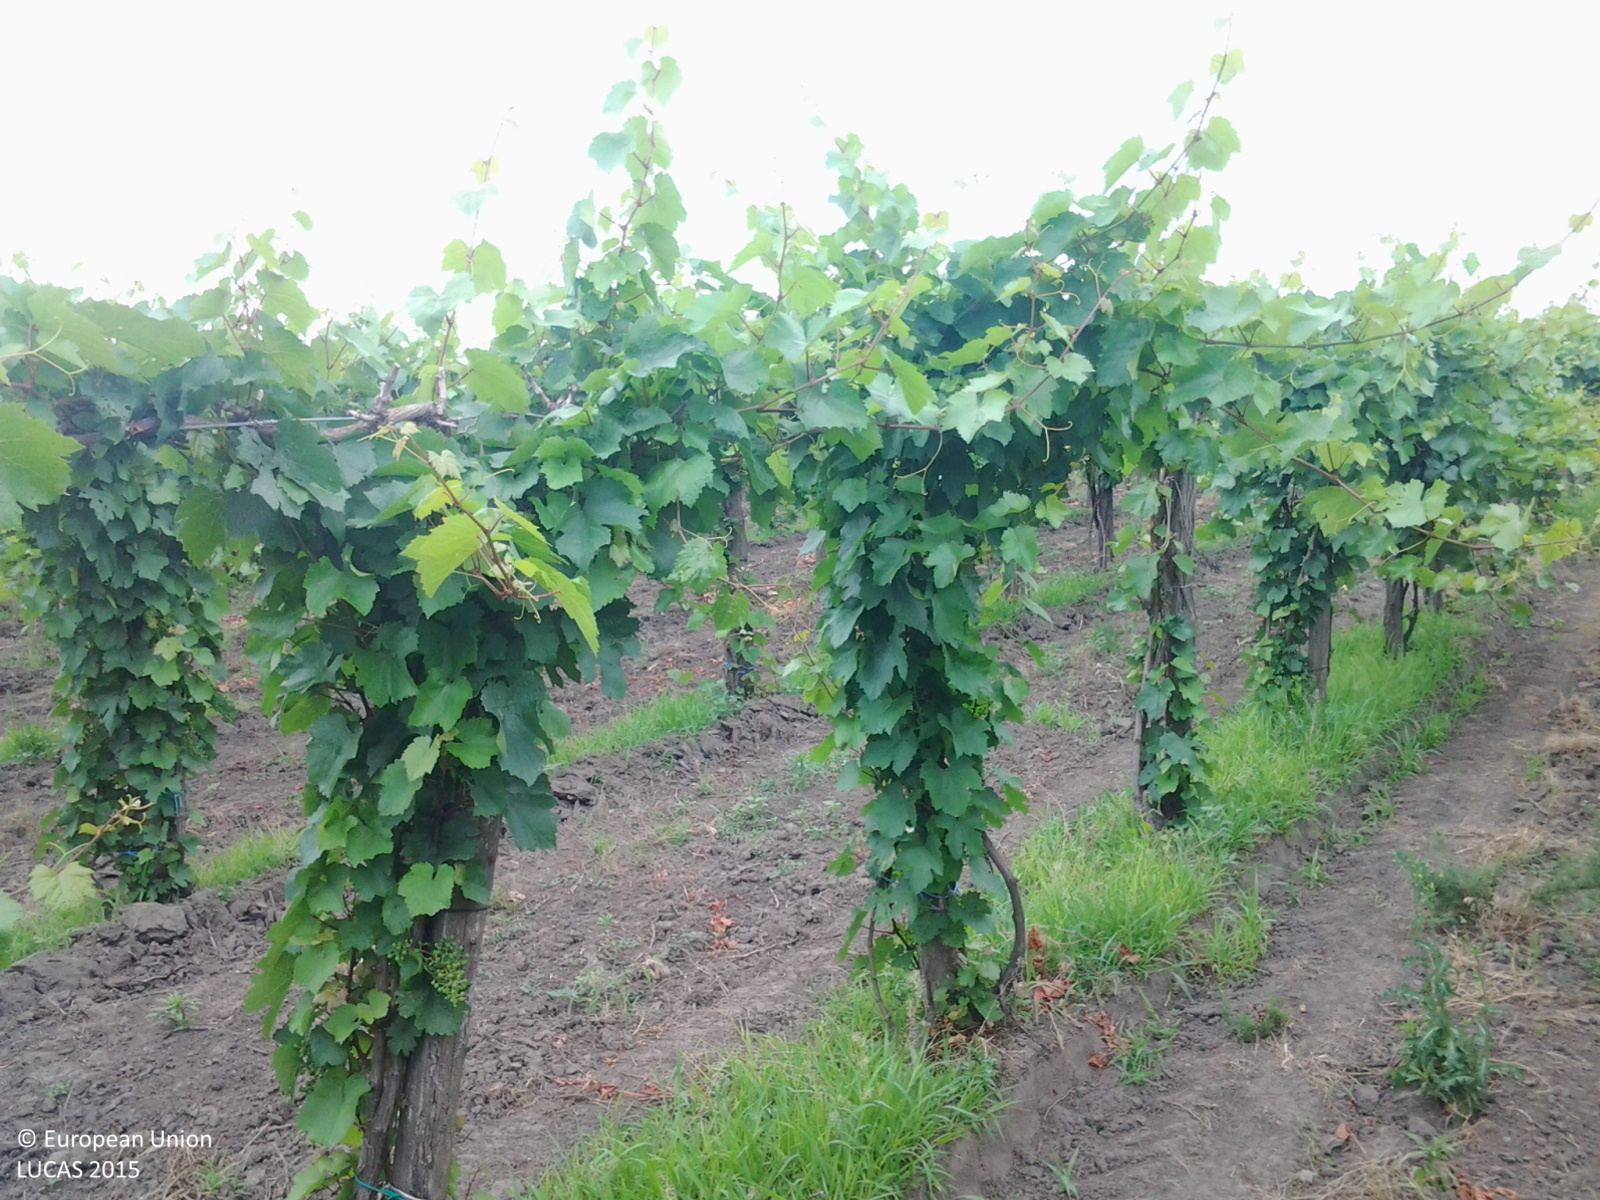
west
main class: Cropland
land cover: Vineyards
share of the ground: 25 - 50 %
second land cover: Other bare soil
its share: > 75 %
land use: Agriculture (excluding fallow land and kitchen gardens)
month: June
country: HU
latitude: 46.4037
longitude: 19.0275
